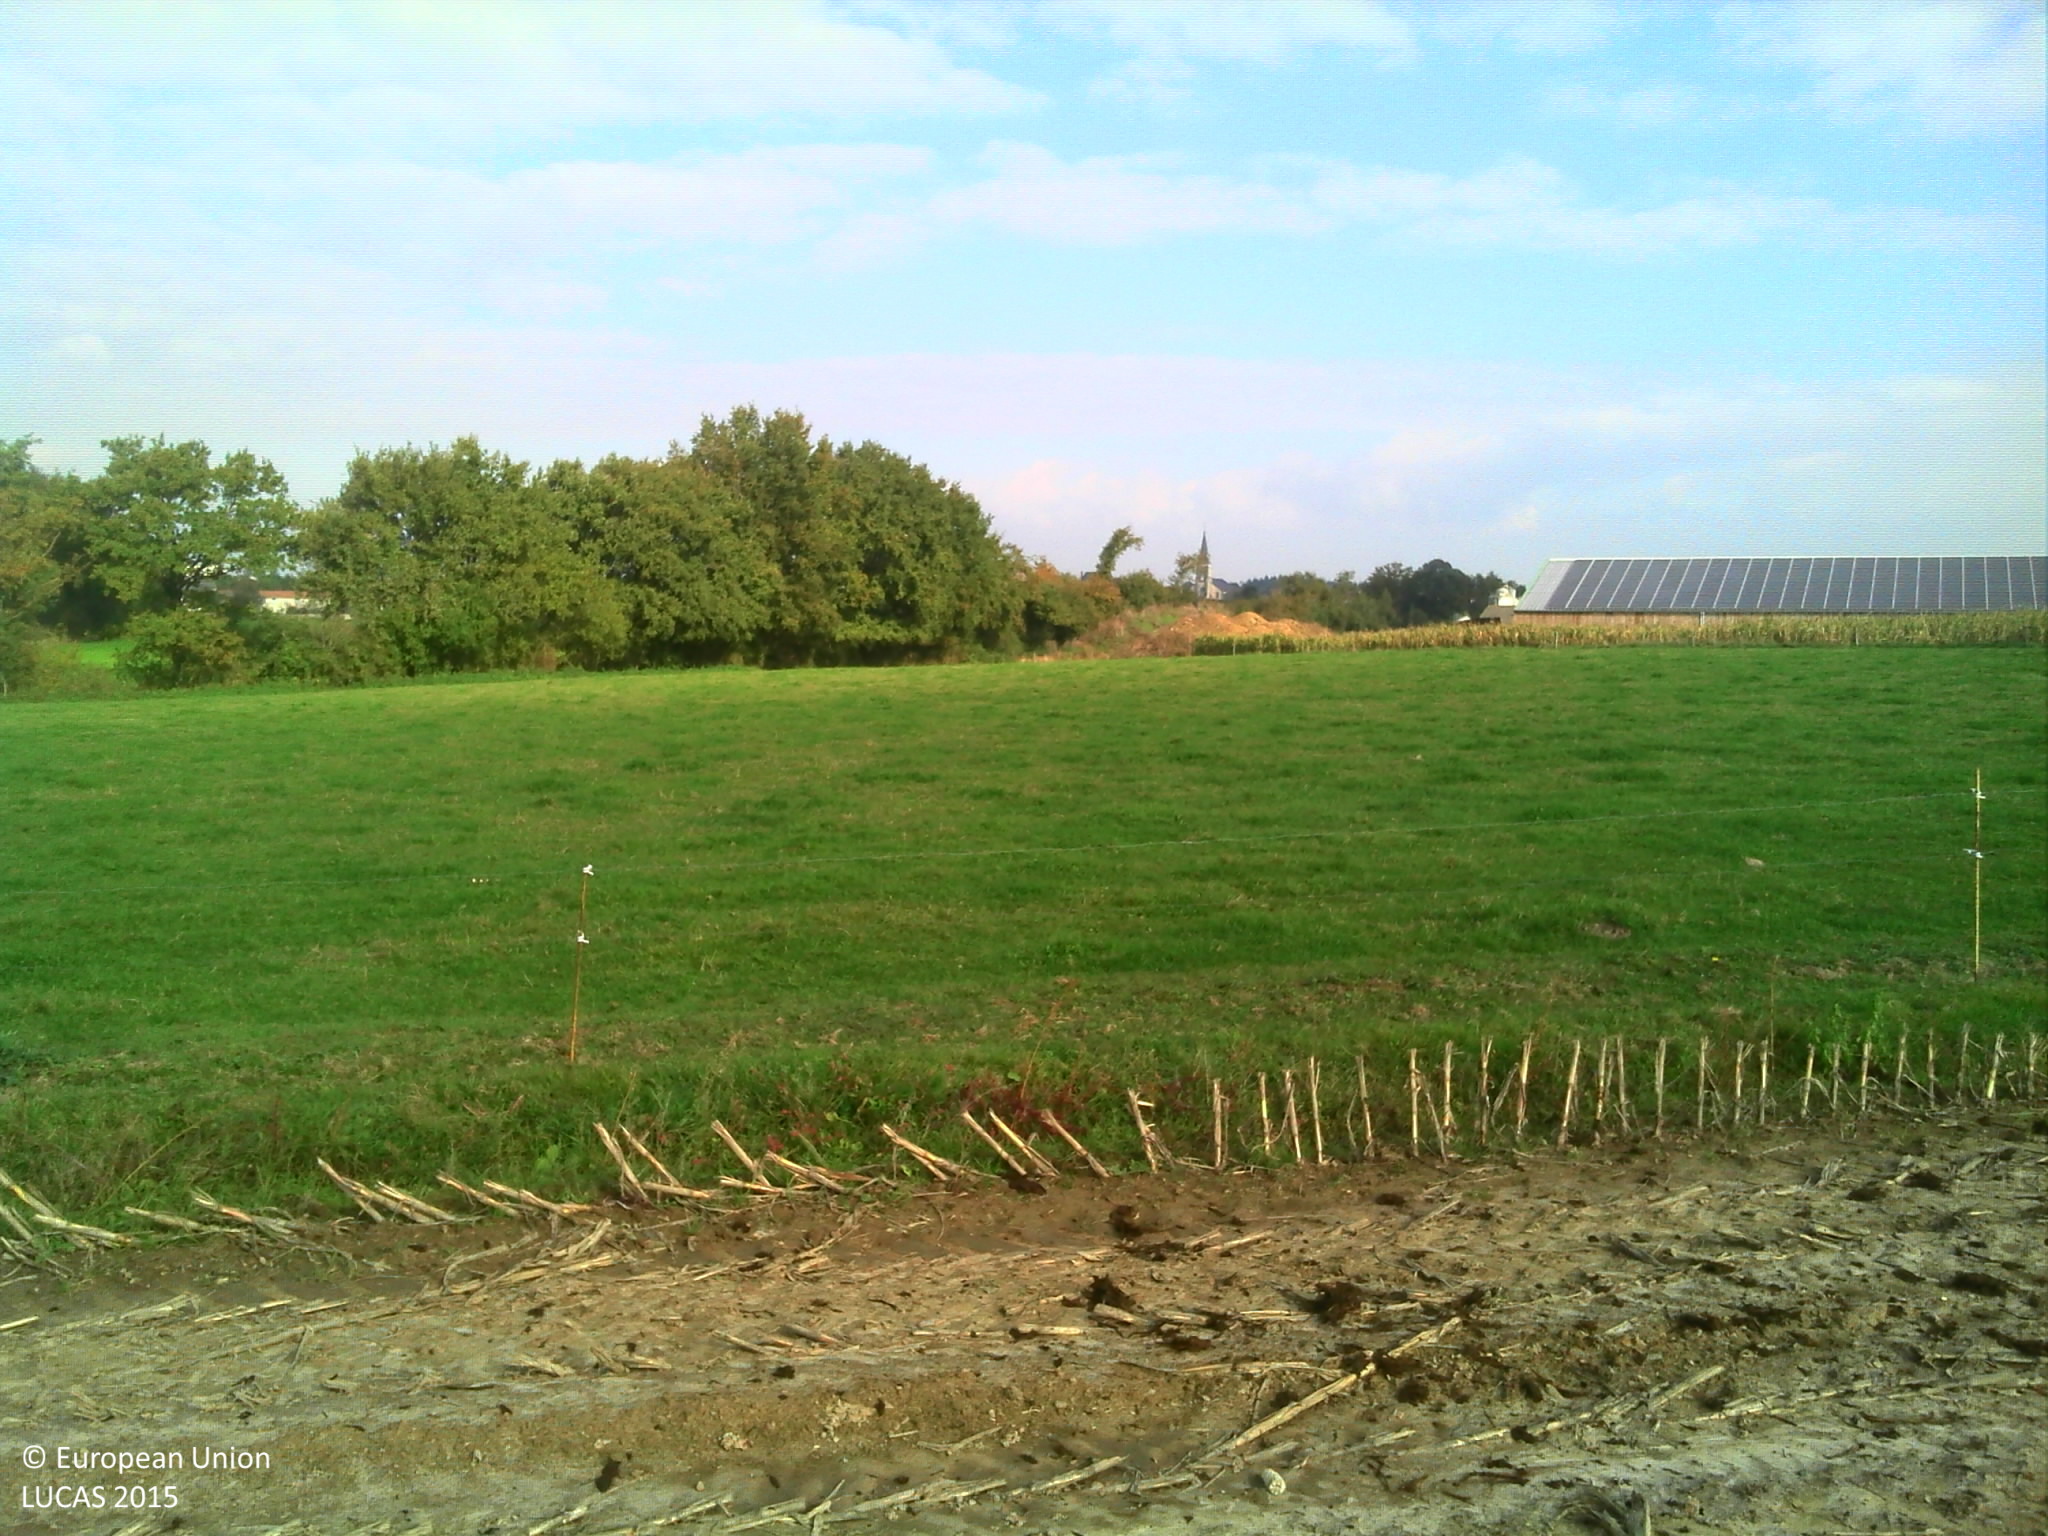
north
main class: Cropland
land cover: Maize
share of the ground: 25 - 50 %
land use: Agriculture (excluding fallow land and kitchen gardens)
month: October
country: FR
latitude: 47.1328
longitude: -0.9372
